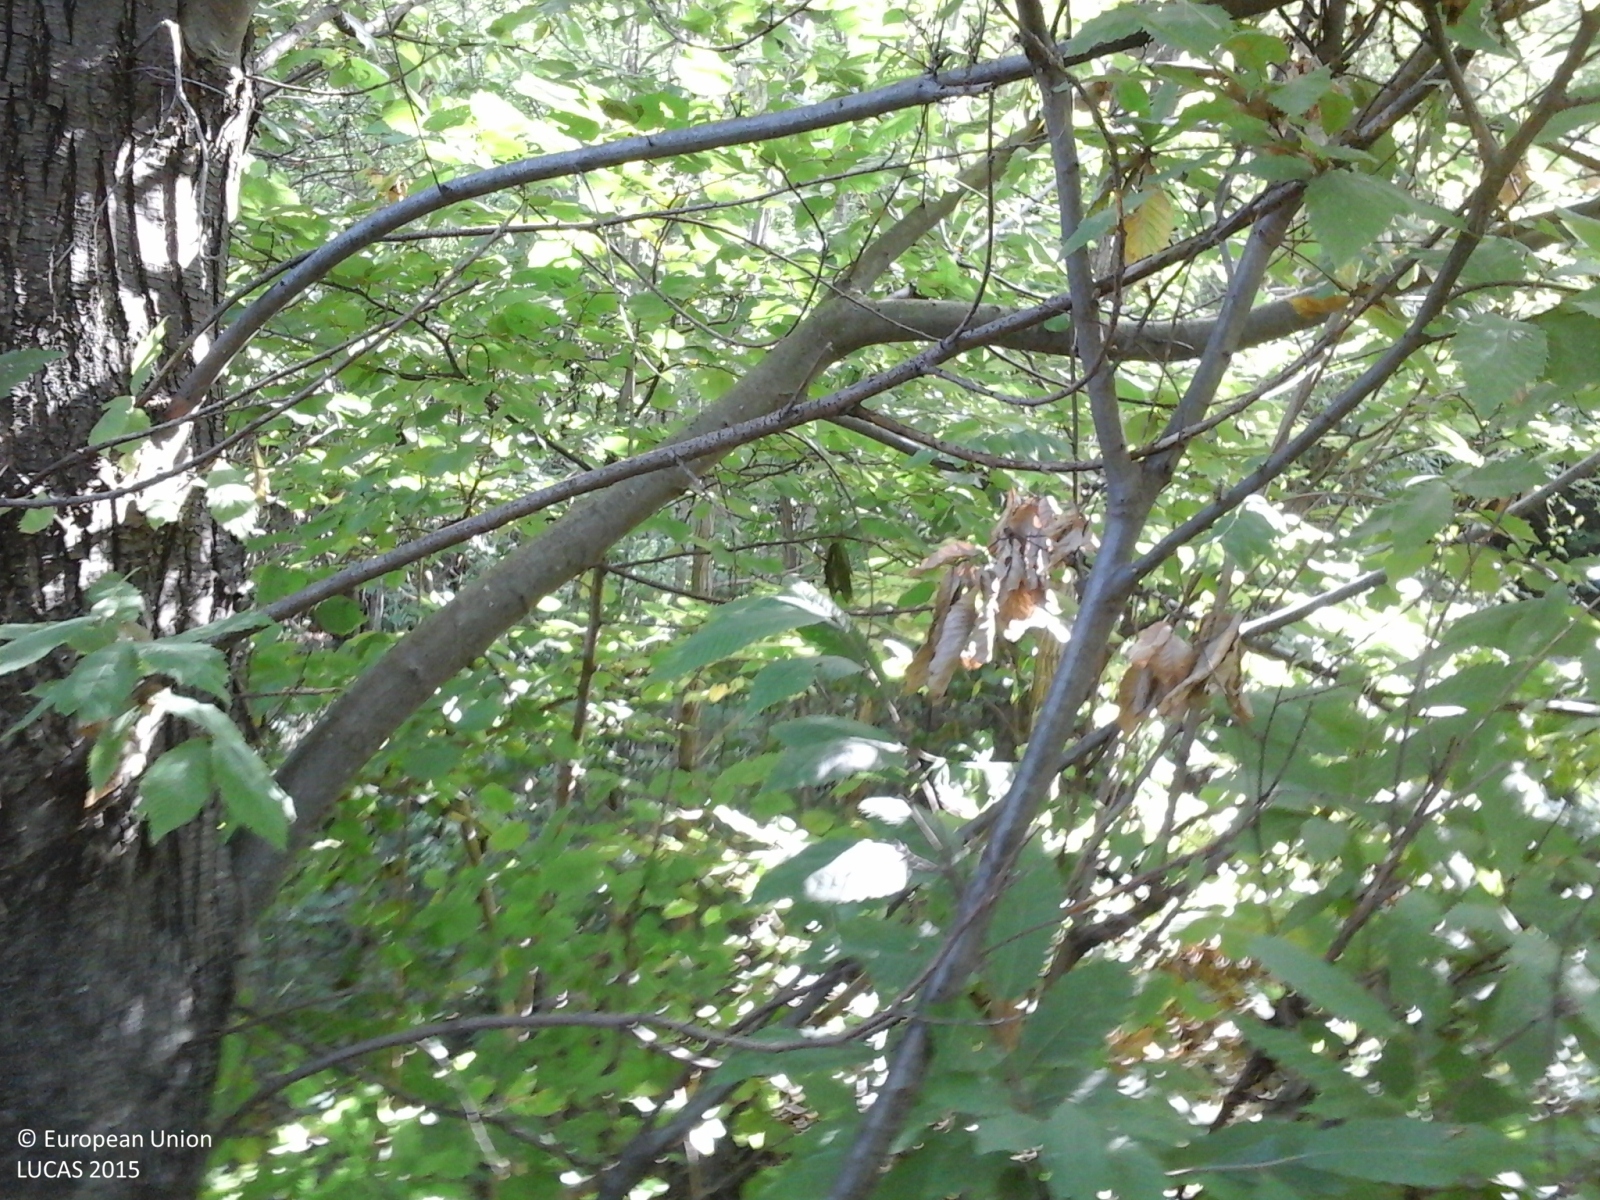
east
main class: Woodland
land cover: Broadleaved woodland
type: thermophilous deciduous forest
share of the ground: > 75 %
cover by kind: broadleaved forest trees 100 %
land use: Forestry
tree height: > 5 m
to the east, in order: Broadleaved woodland
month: September
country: IT
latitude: 44.4841
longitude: 8.5070
